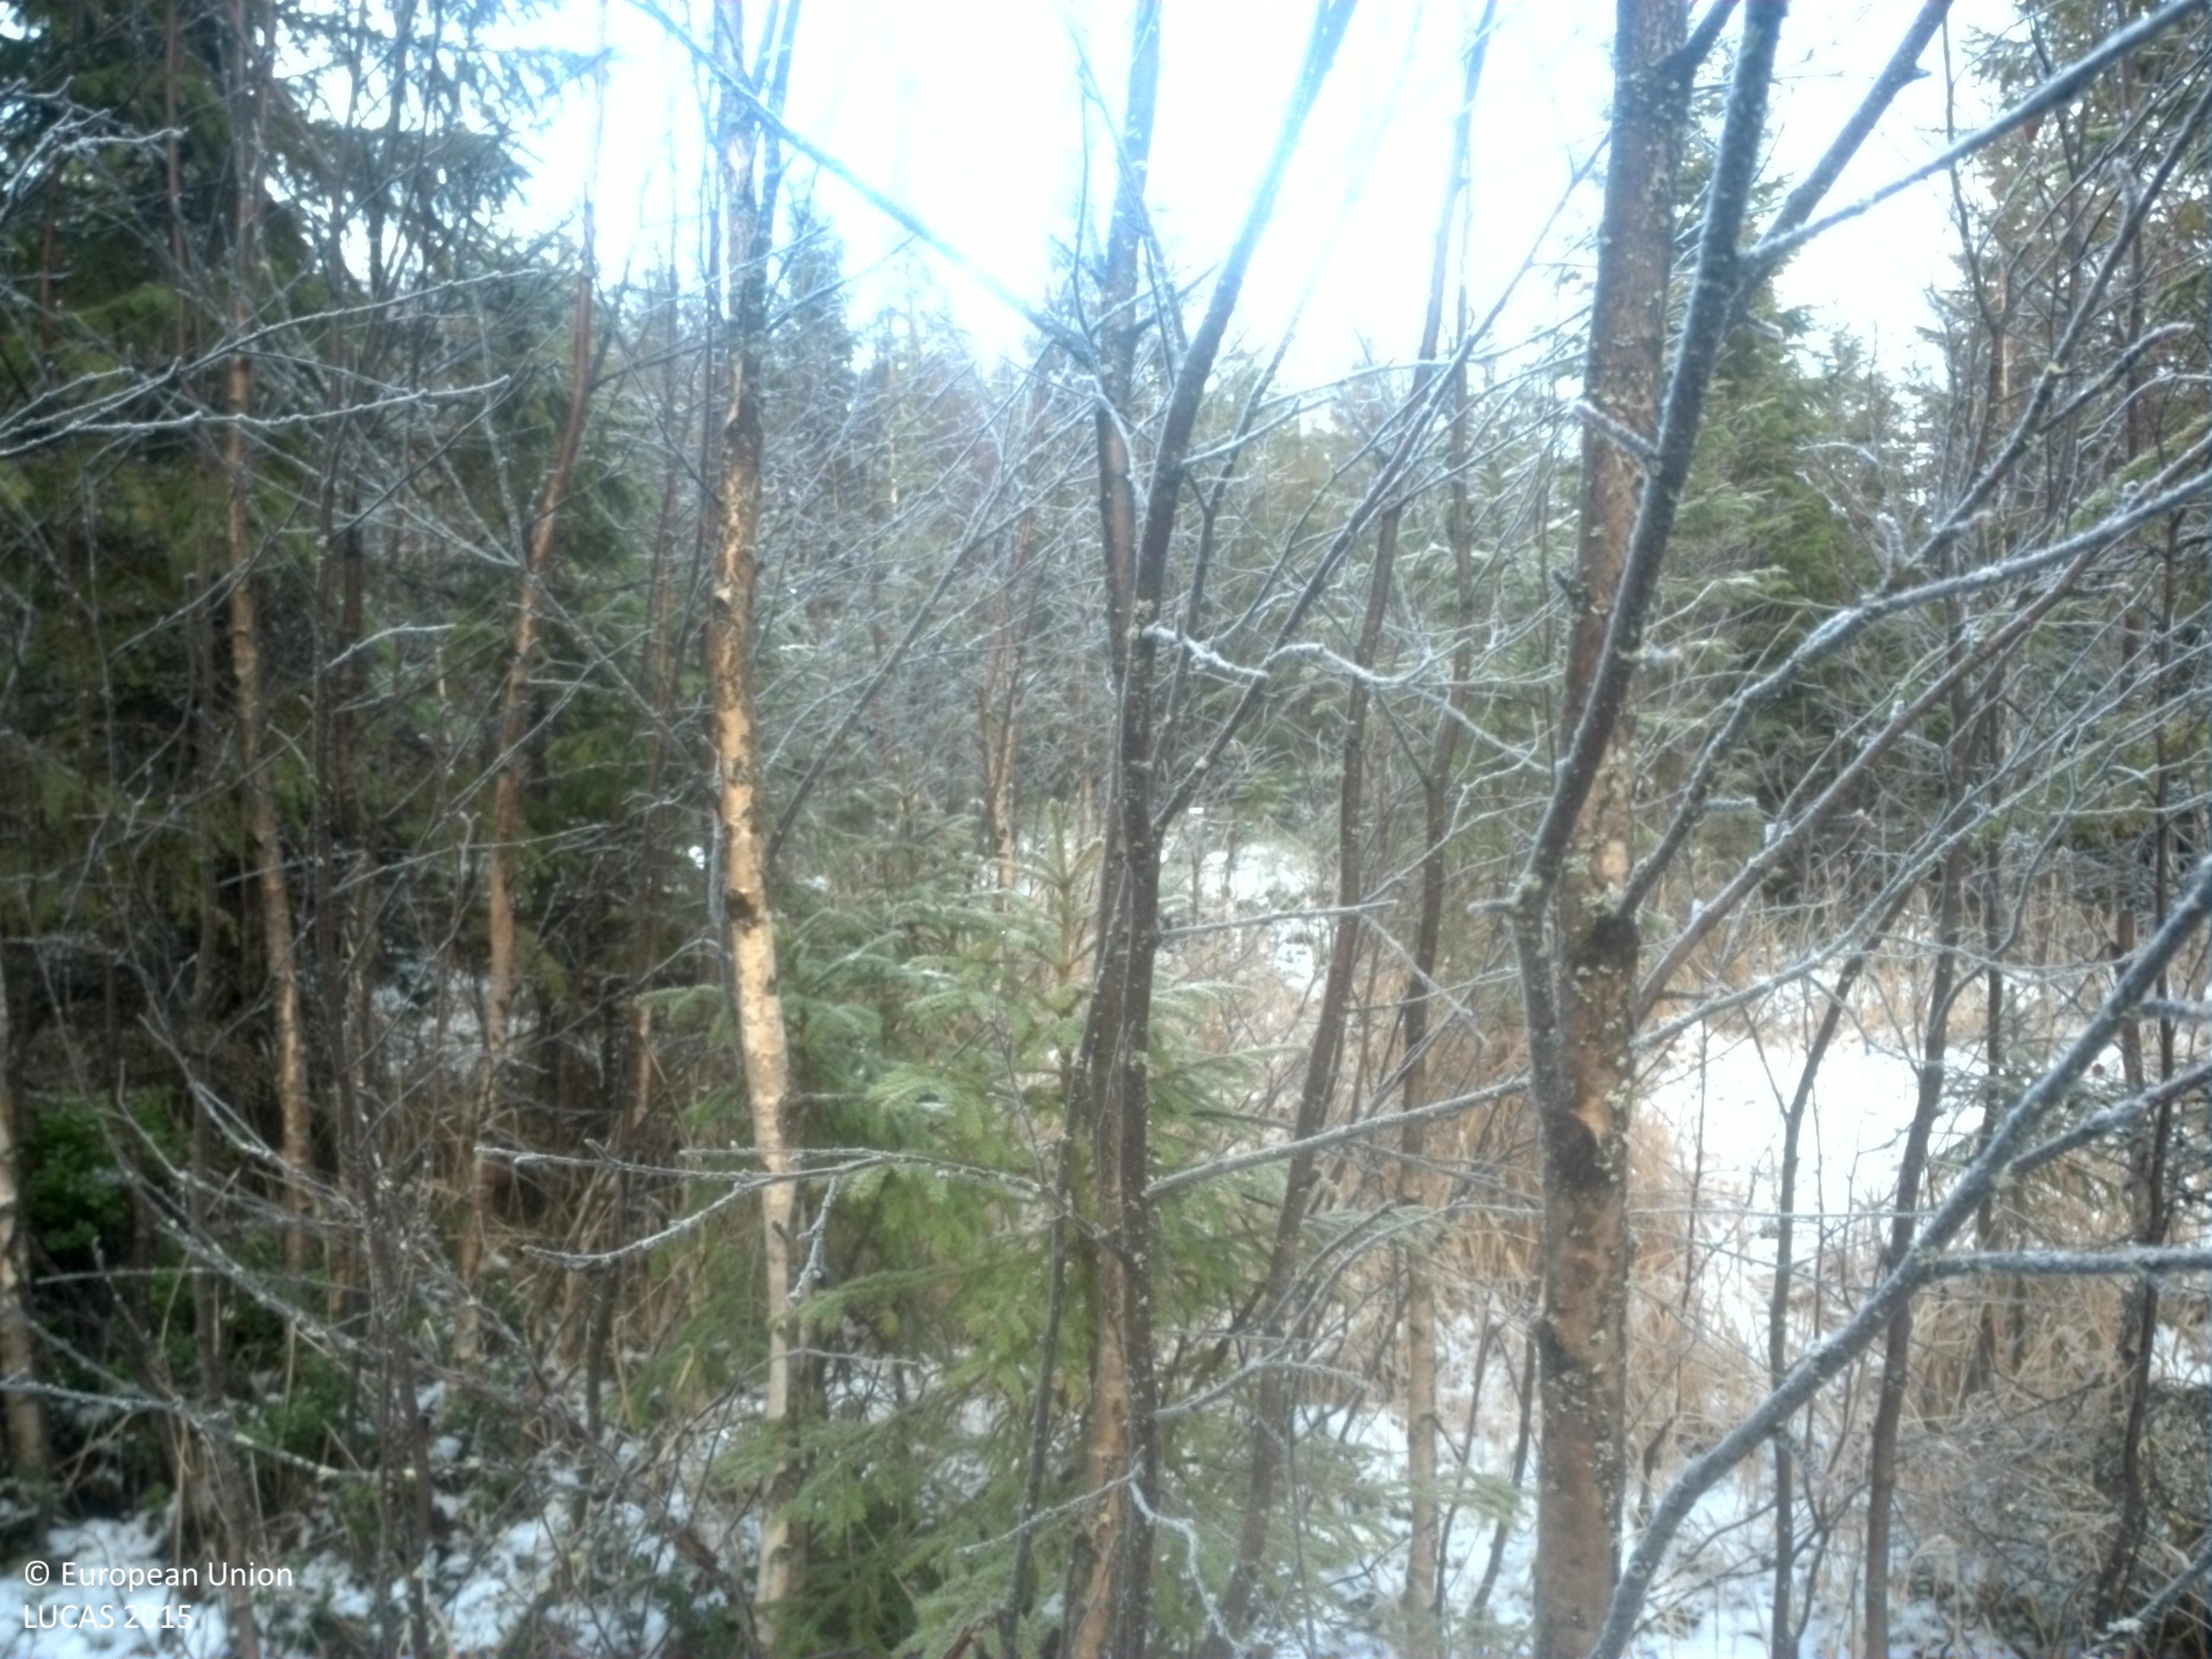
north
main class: Woodland
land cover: Spruce dominated mixed woodland
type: boreal forest
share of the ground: 50 - 75 %
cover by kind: coniferous forest trees 35 %, shrubs 25 %, broadleaved forest trees 15 %, lichens and mosses 15 %, herbaceous plants 10 %
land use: Forestry
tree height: < 5 m
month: November
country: SE
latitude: 63.9050
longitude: 15.9833
